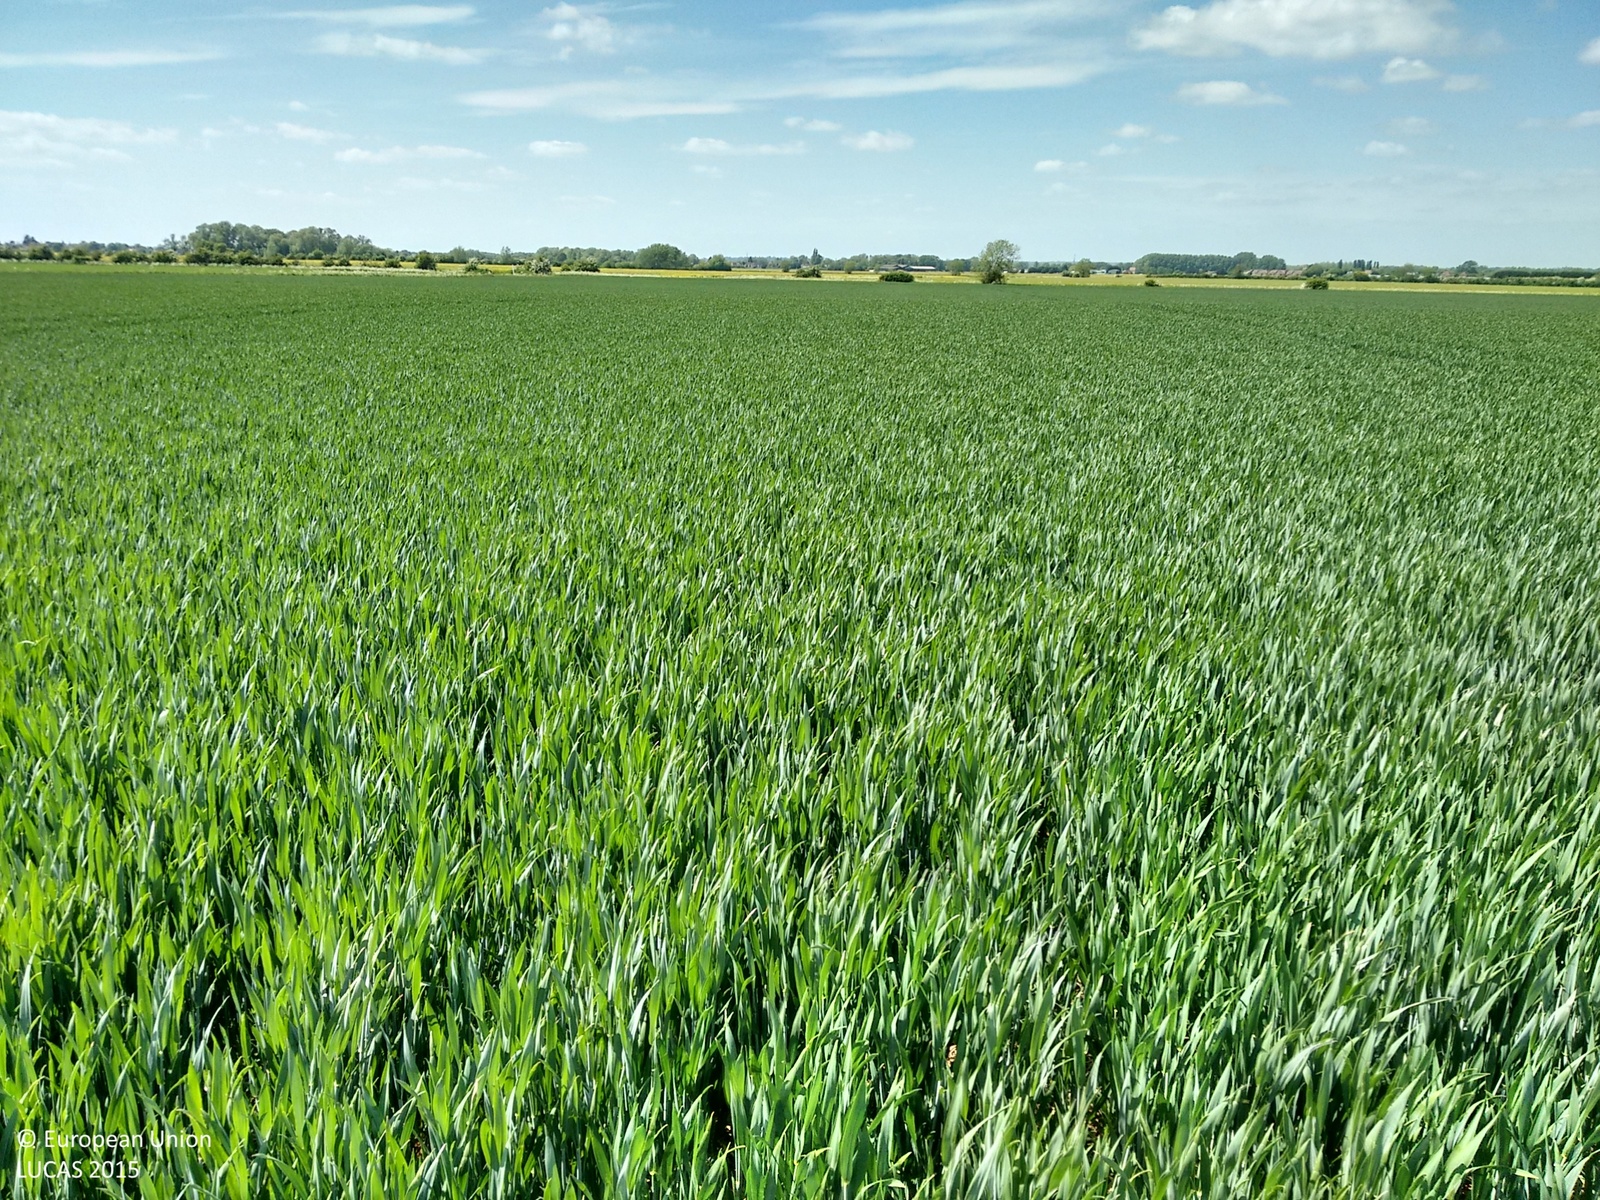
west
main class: Cropland
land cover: Common wheat
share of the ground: > 75 %
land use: Agriculture (excluding fallow land and kitchen gardens)
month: May
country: GB
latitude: 52.1221
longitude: -0.3629
